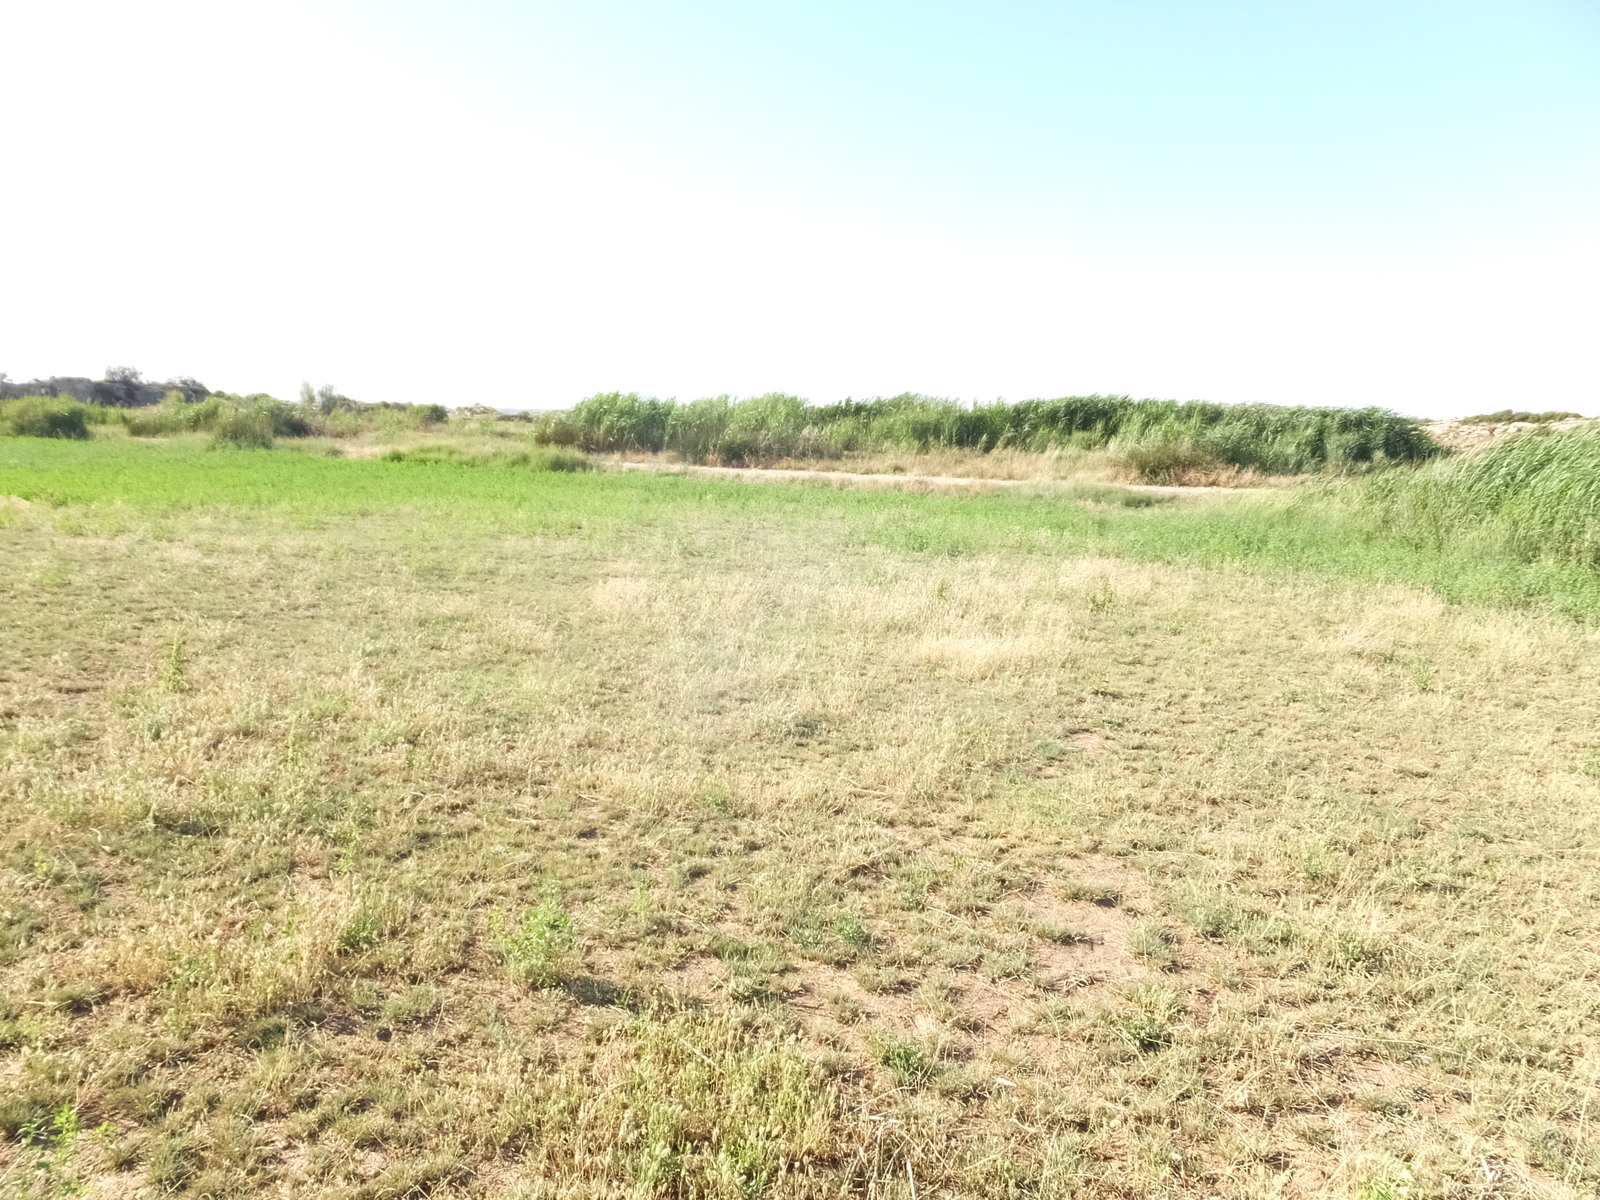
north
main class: Cropland
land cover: Lucerne
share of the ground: > 75 %
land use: Agriculture (excluding fallow land and kitchen gardens)
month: June
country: ES
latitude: 41.2136
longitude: -0.1630
